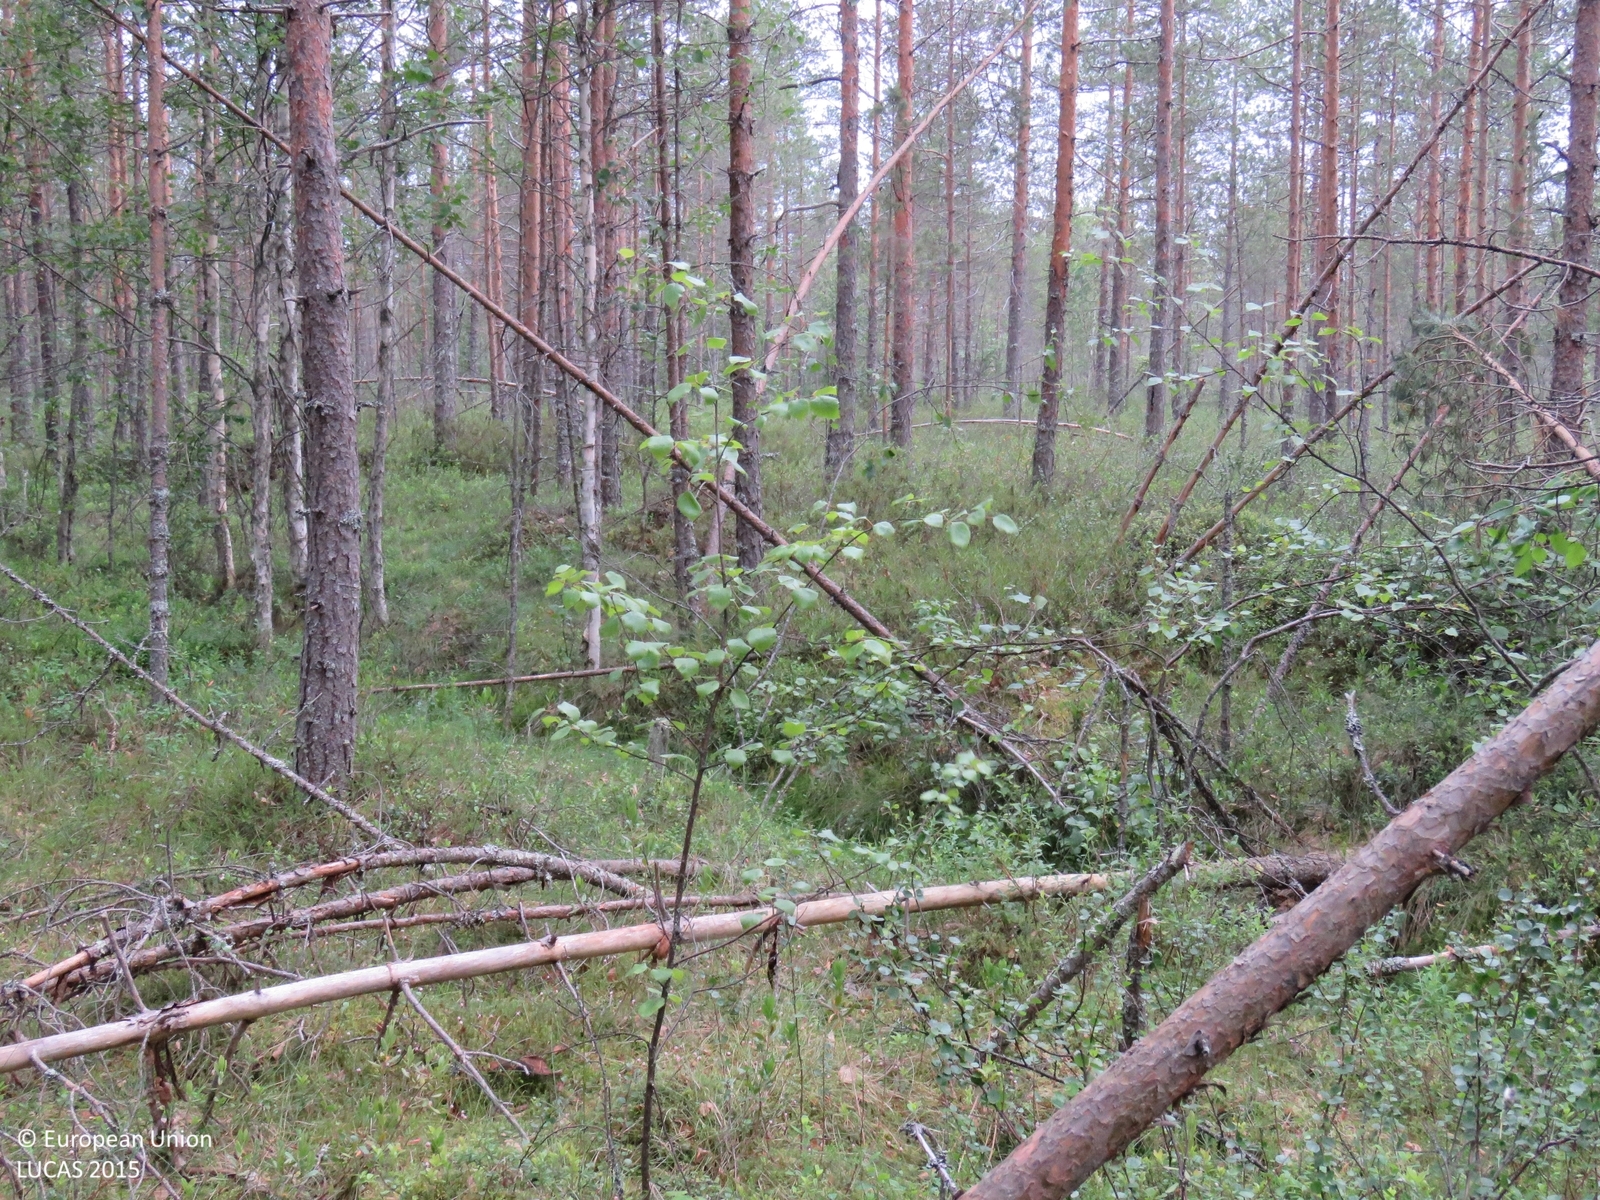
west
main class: Woodland
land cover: Pine dominated coniferous woodland
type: mire and swamp forests
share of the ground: > 75 %
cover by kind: coniferous forest trees 70 %, broadleaved forest trees 20 %, shrubs 10 %
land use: Forestry
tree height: > 5 m
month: July
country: FI
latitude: 64.2814
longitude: 26.5380
